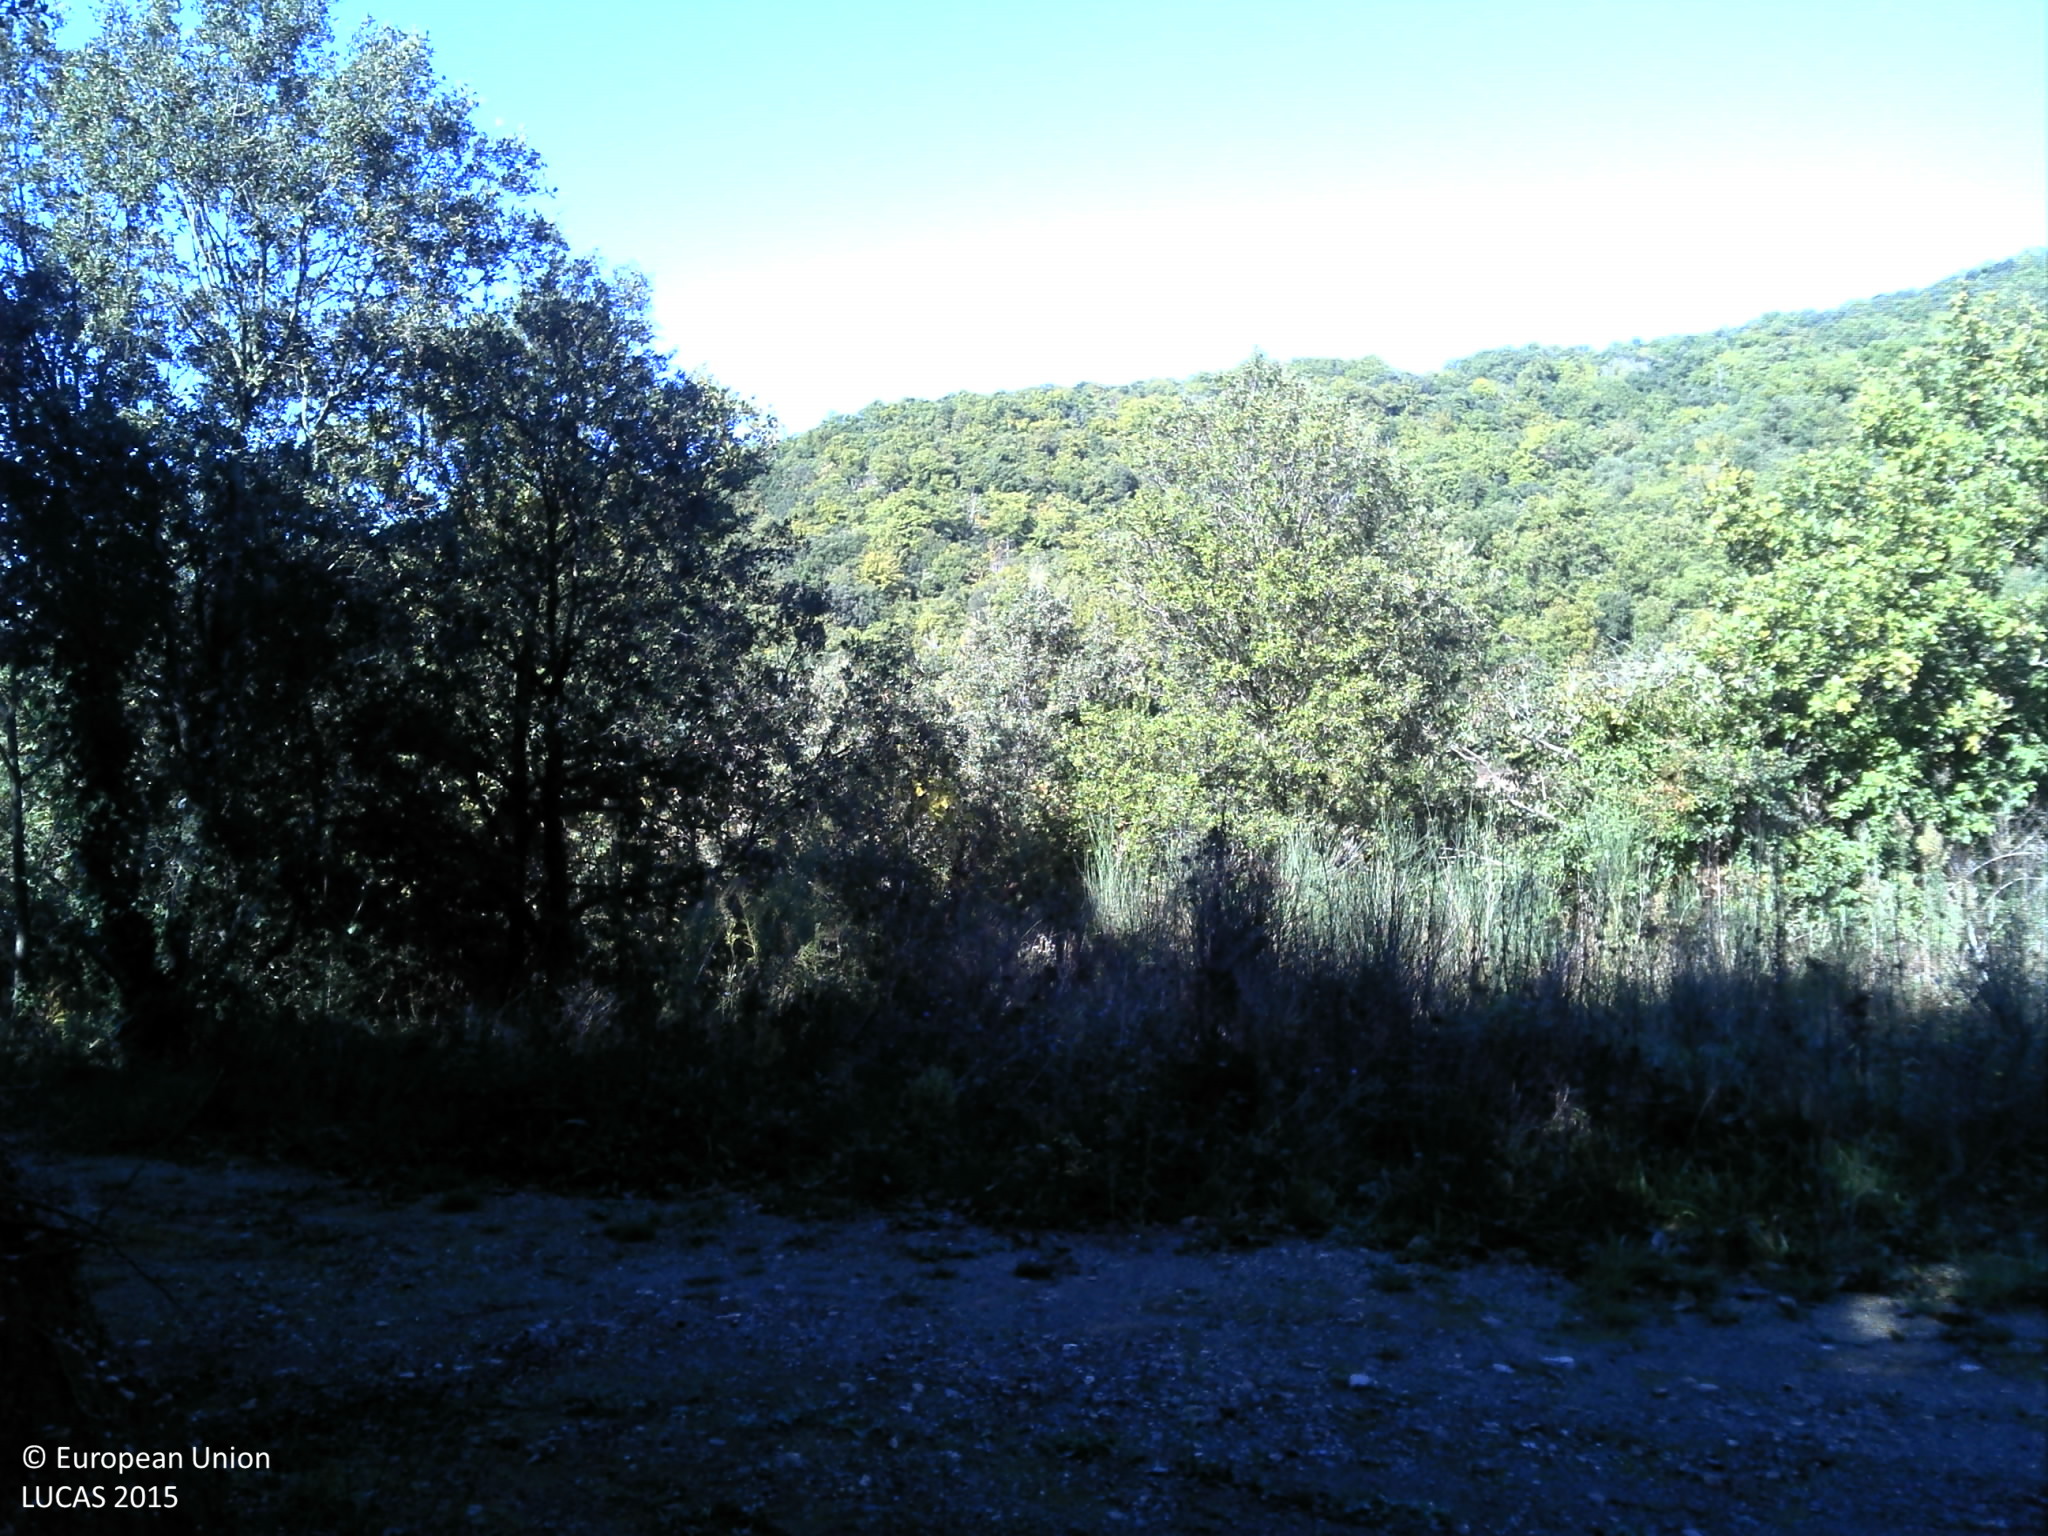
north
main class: Woodland
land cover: Broadleaved woodland
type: mesophytic deciduous forest
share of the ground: > 75 %
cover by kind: broadleaved forest trees 90 %, herbaceous plants 5 %, lichens and mosses 5 %
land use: Forestry
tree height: > 5 m
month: October
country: FR
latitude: 43.5801
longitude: 3.1352
